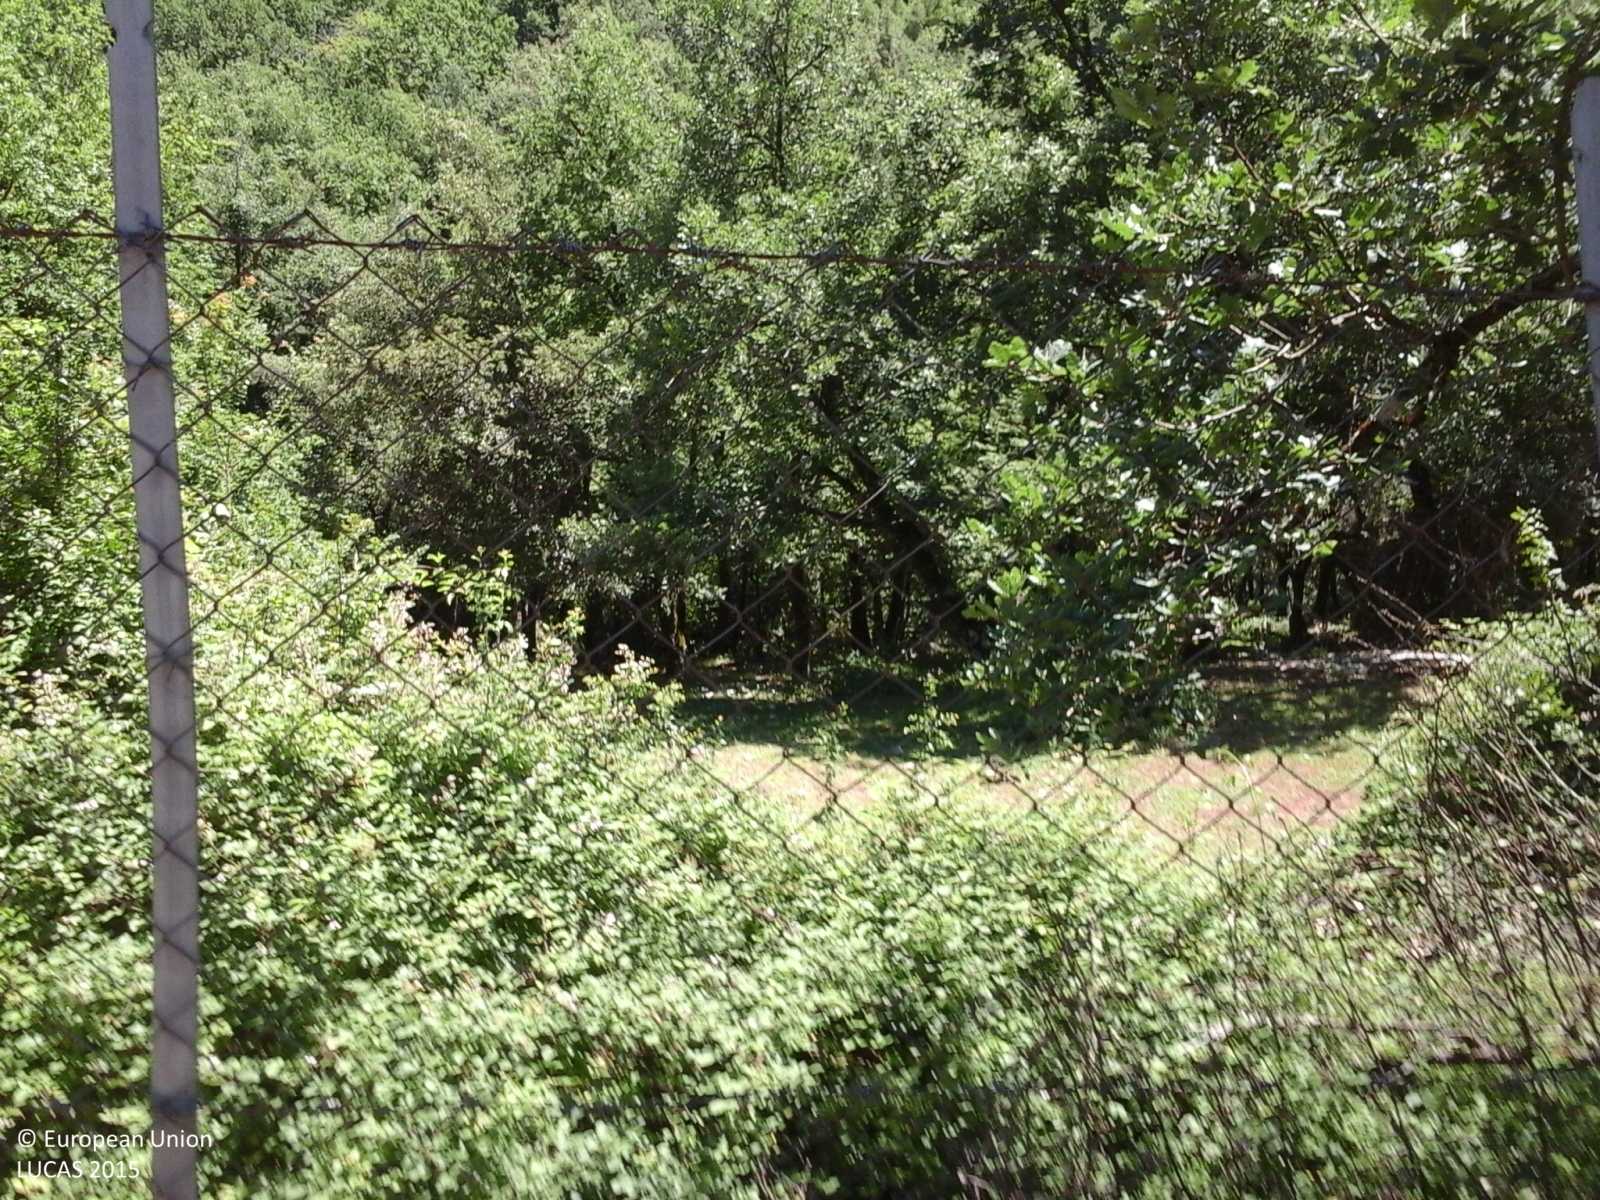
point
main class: Woodland
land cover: Broadleaved woodland
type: thermophilous deciduous forest
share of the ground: > 75 %
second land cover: Grassland without tree/shrub cover
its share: > 75 %
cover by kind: broadleaved forest trees 70 %, herbaceous plants 30 %
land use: Forestry
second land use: Agriculture (excluding fallow land and kitchen gardens)
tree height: > 5 m
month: June
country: IT
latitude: 41.6311
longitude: 13.0732
